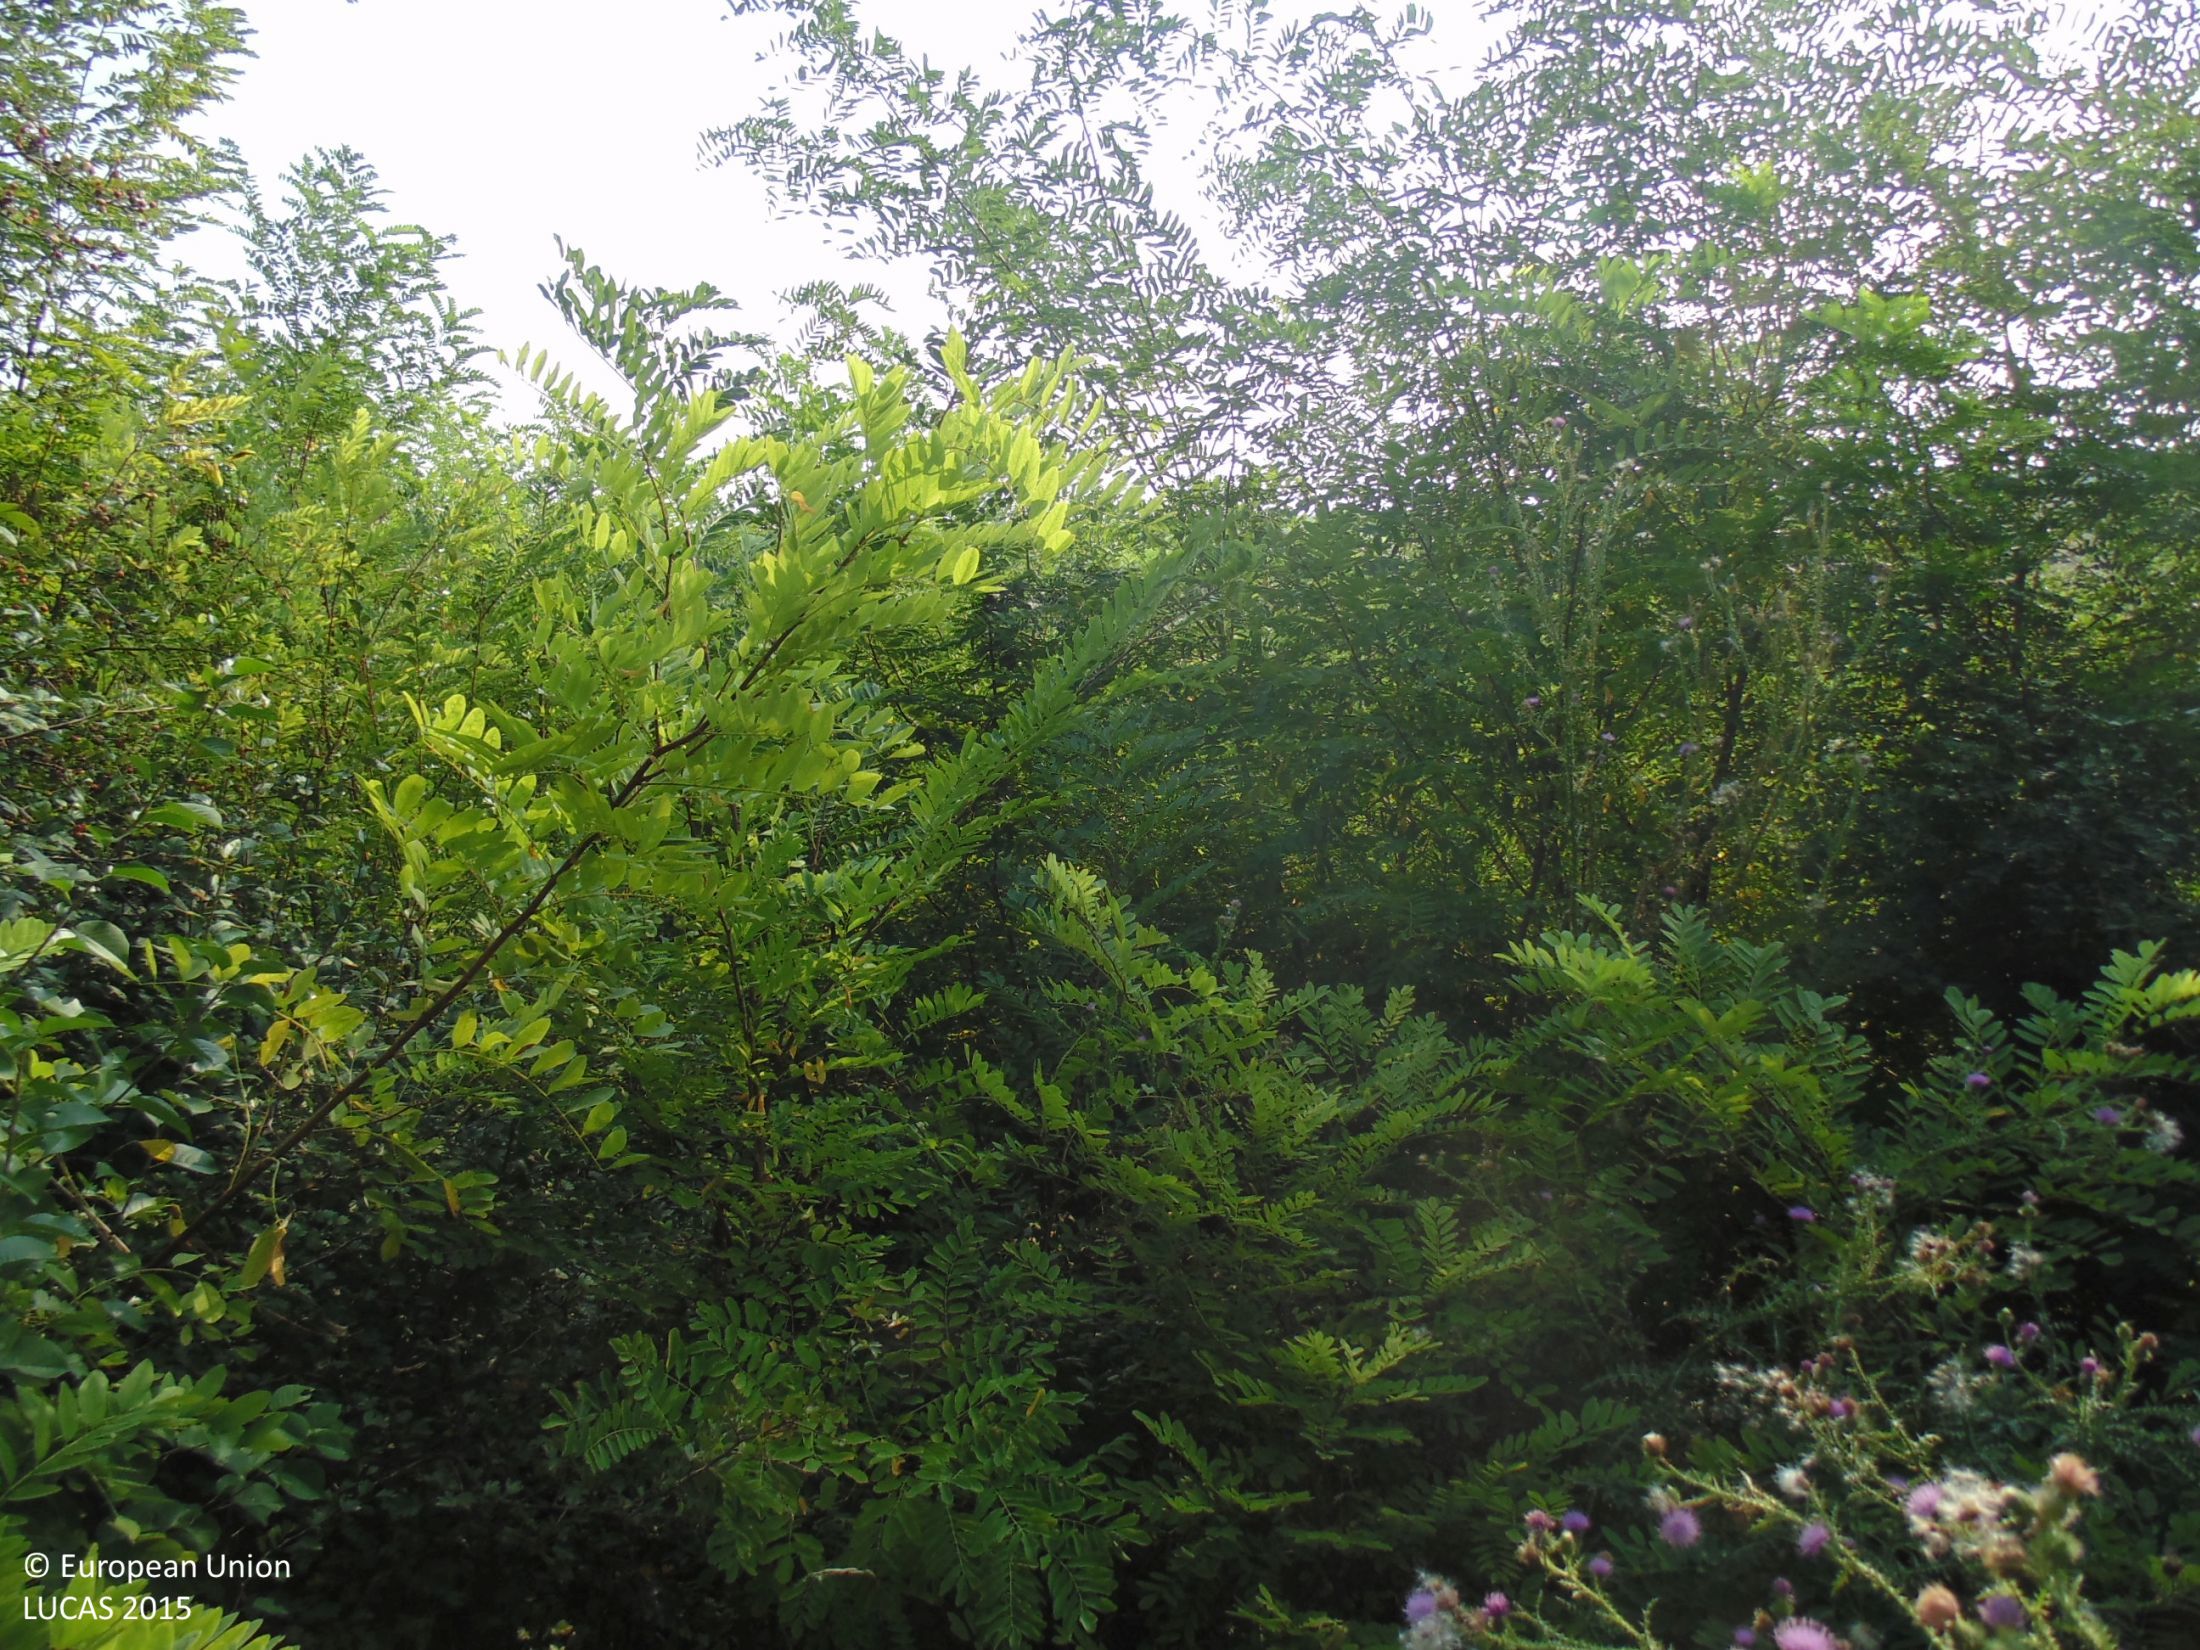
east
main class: Woodland
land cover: Broadleaved woodland
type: mesophytic deciduous forest
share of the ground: > 75 %
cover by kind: broadleaved forest trees 85 %, unconsolidated bare surface 10 %, shrubs 5 %
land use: Forestry
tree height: > 5 m
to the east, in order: Broadleaved woodland; Spontaneously vegetated surfaces; Grass margins; Sunflower
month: August
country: BG
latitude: 44.0112
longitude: 27.3845
